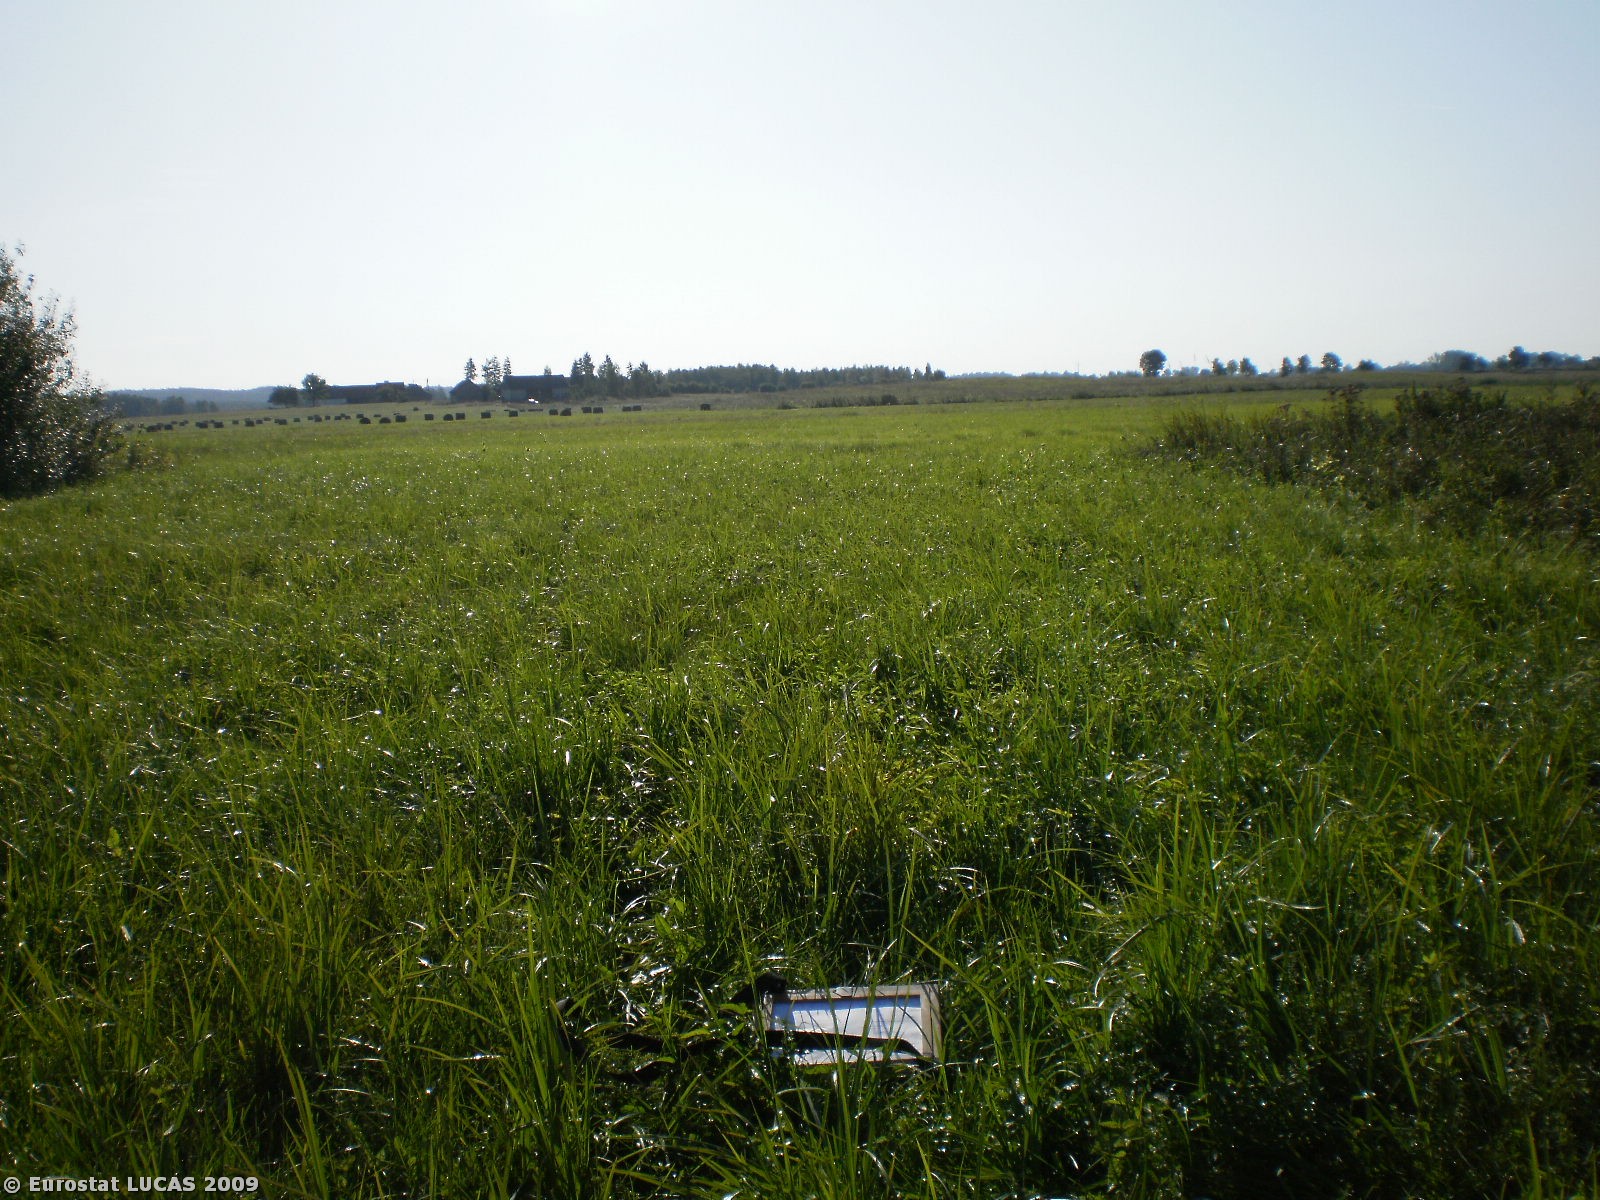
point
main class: Grassland
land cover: Grassland without tree/shrub cover
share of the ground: > 75 %
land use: Agriculture (excluding fallow land and kitchen gardens)
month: September
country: PL
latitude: 53.8670
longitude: 22.0872
